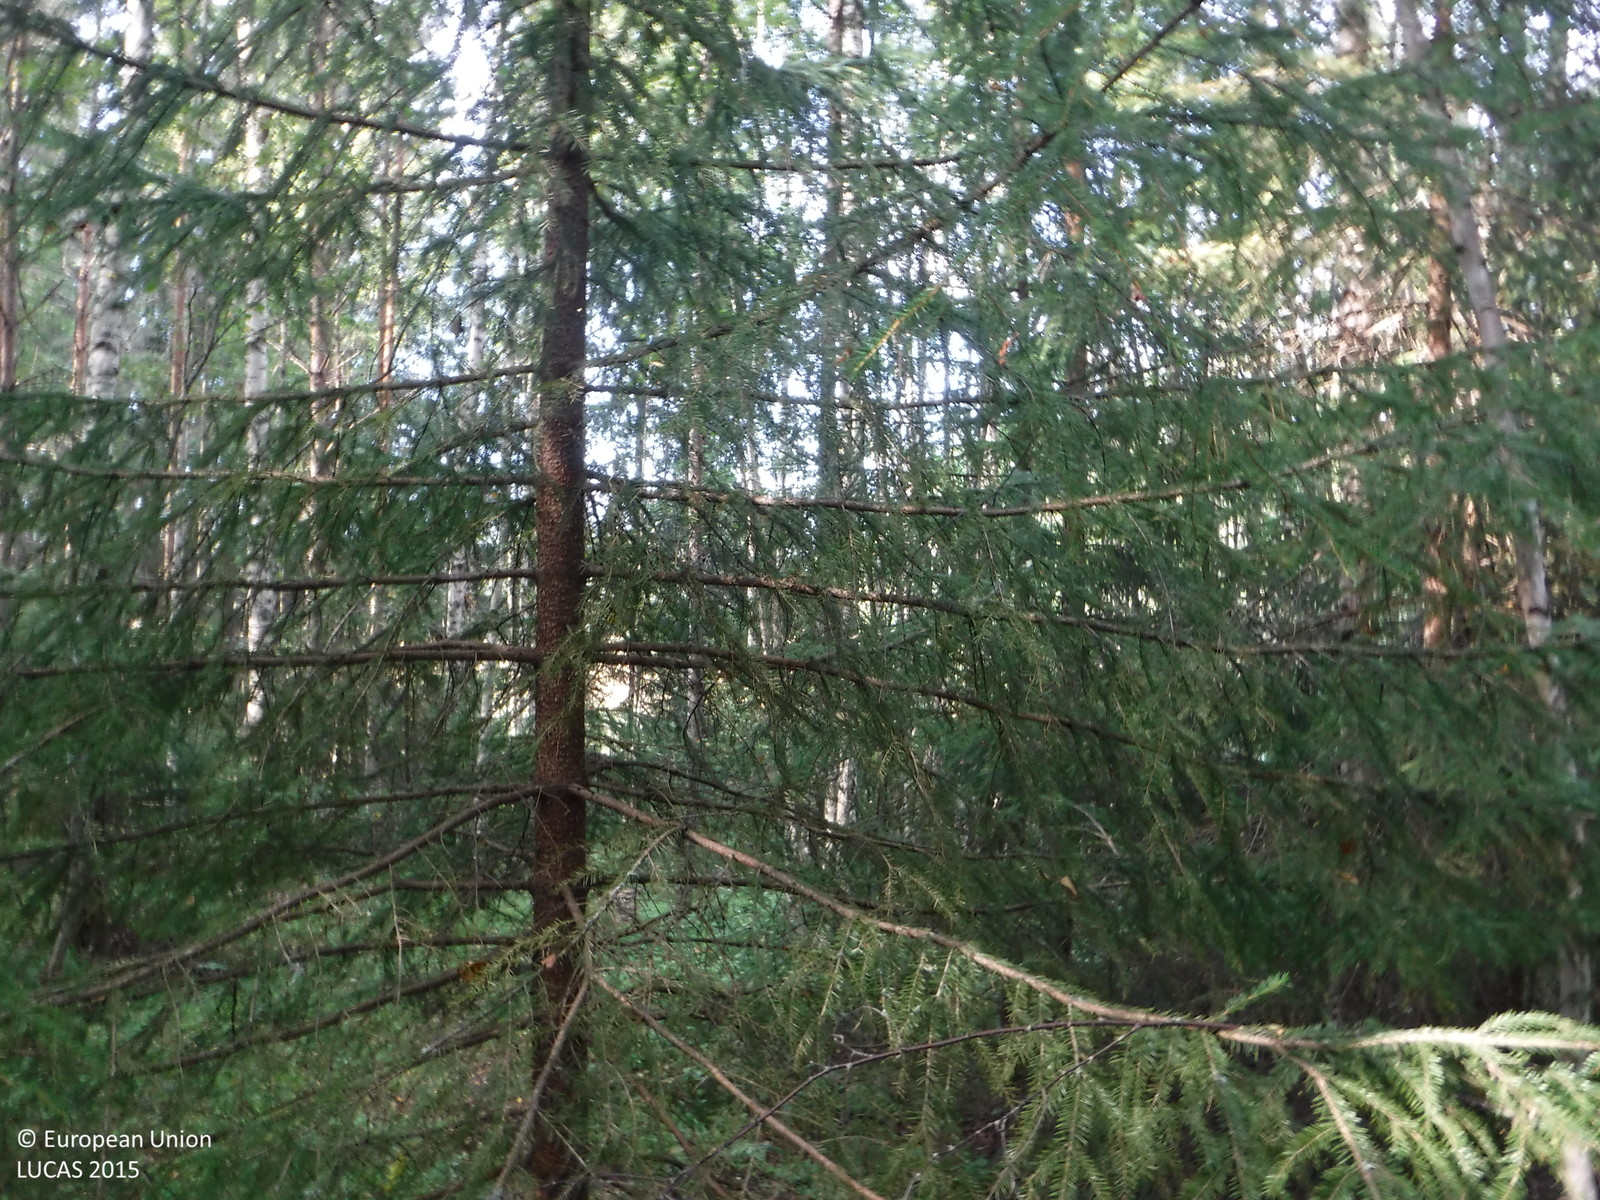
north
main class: Woodland
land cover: Other mixed woodland
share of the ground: 50 - 75 %
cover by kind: coniferous forest trees 40 %, broadleaved forest trees 30 %, herbaceous plants 20 %, lichens and mosses 10 %
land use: Forestry
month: August
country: FI
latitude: 61.0883
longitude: 21.7940
